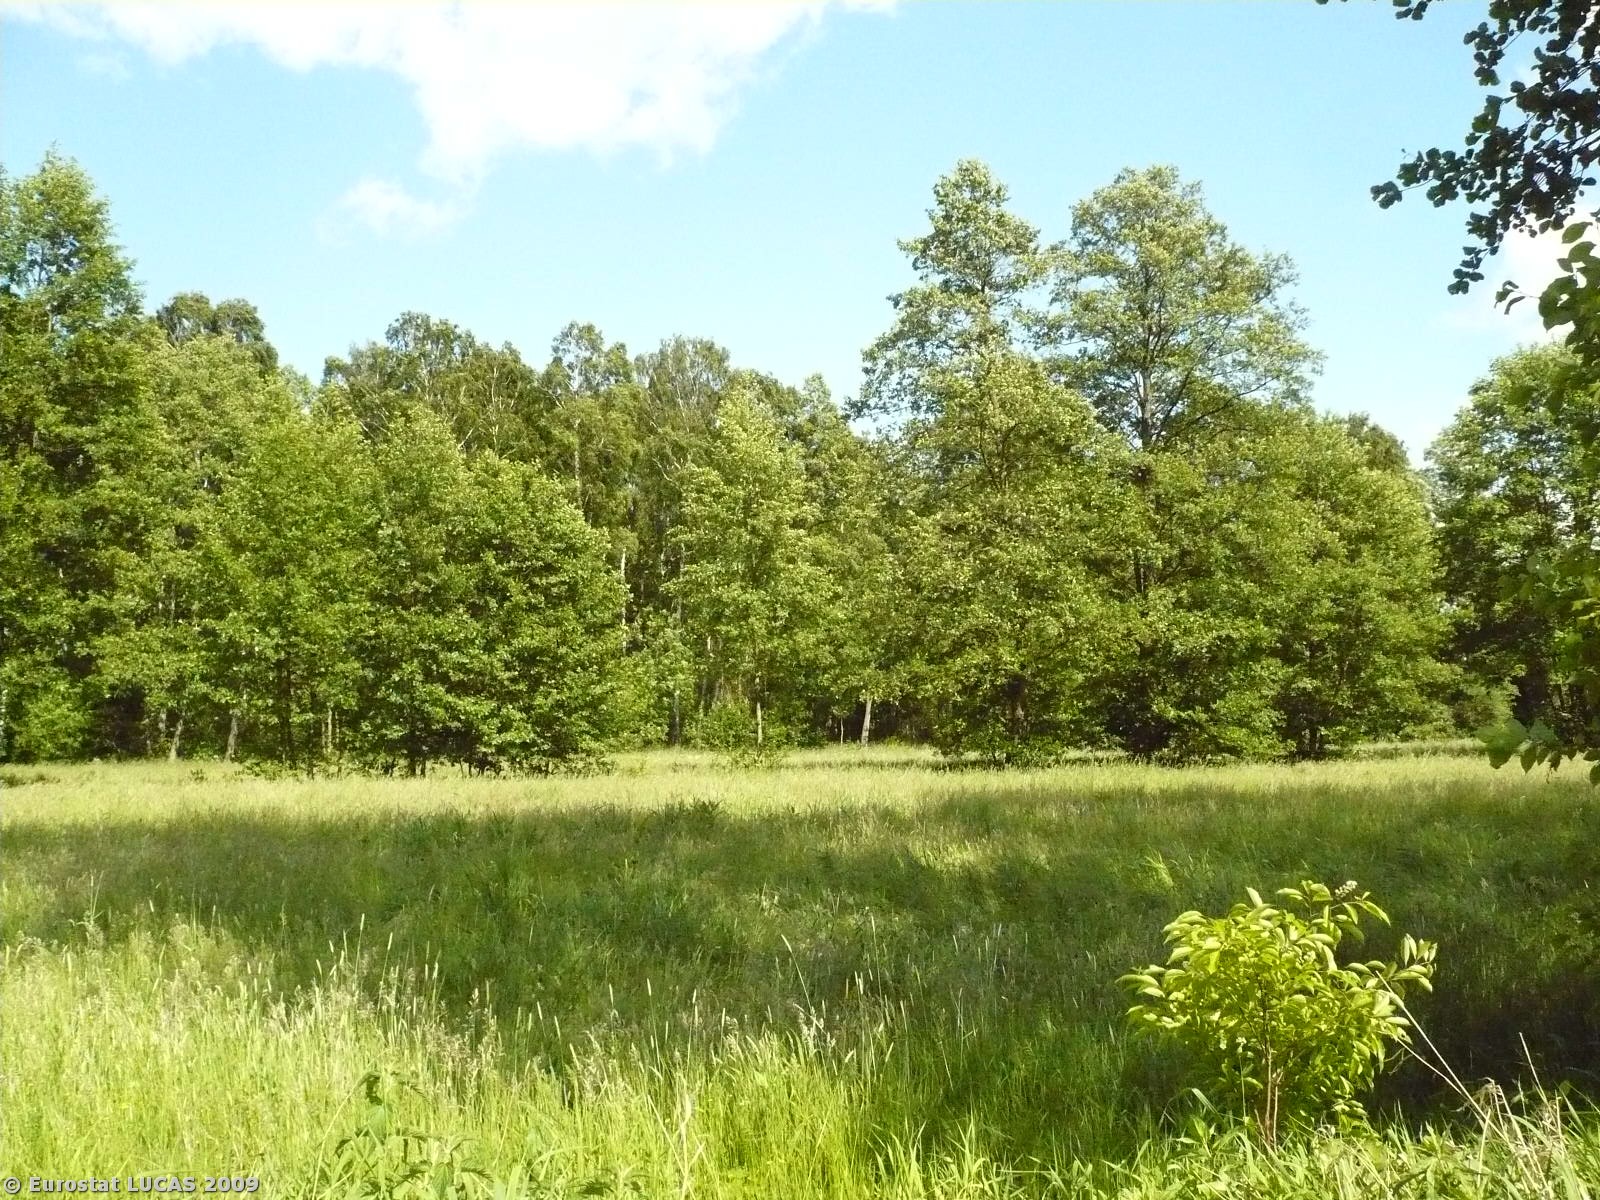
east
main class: Grassland
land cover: Grassland without tree/shrub cover
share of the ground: > 75 %
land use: Agriculture (excluding fallow land and kitchen gardens)
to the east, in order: Grassland without tree/shrub cover; Lines of trees; Grassland without tree/shrub cover; Lines of trees; Mixed woodland; Coniferous woodland
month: May
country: PL
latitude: 52.1005
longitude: 16.3281
